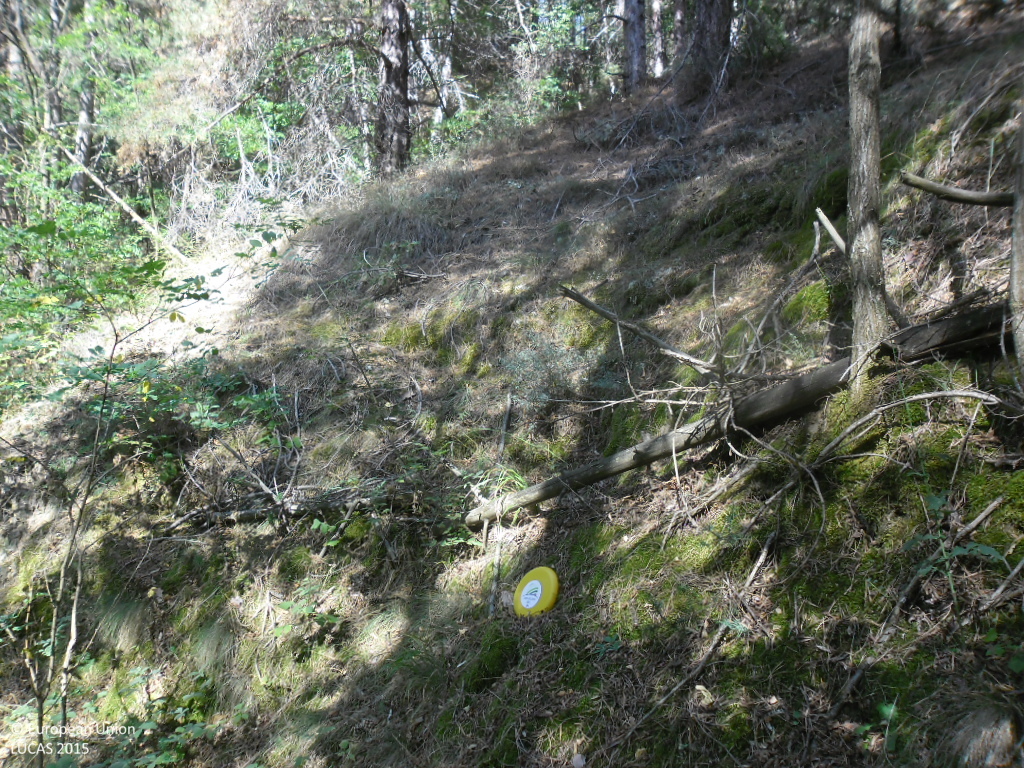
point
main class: Woodland
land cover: Pine dominated coniferous woodland
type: hemiboreal forest and nemoral coniferous forest and mixed broadleaved-coniferous forest
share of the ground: > 75 %
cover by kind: coniferous forest trees 100 %
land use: Forestry
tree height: < 5 m
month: September
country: BG
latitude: 41.8007
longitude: 23.2264
